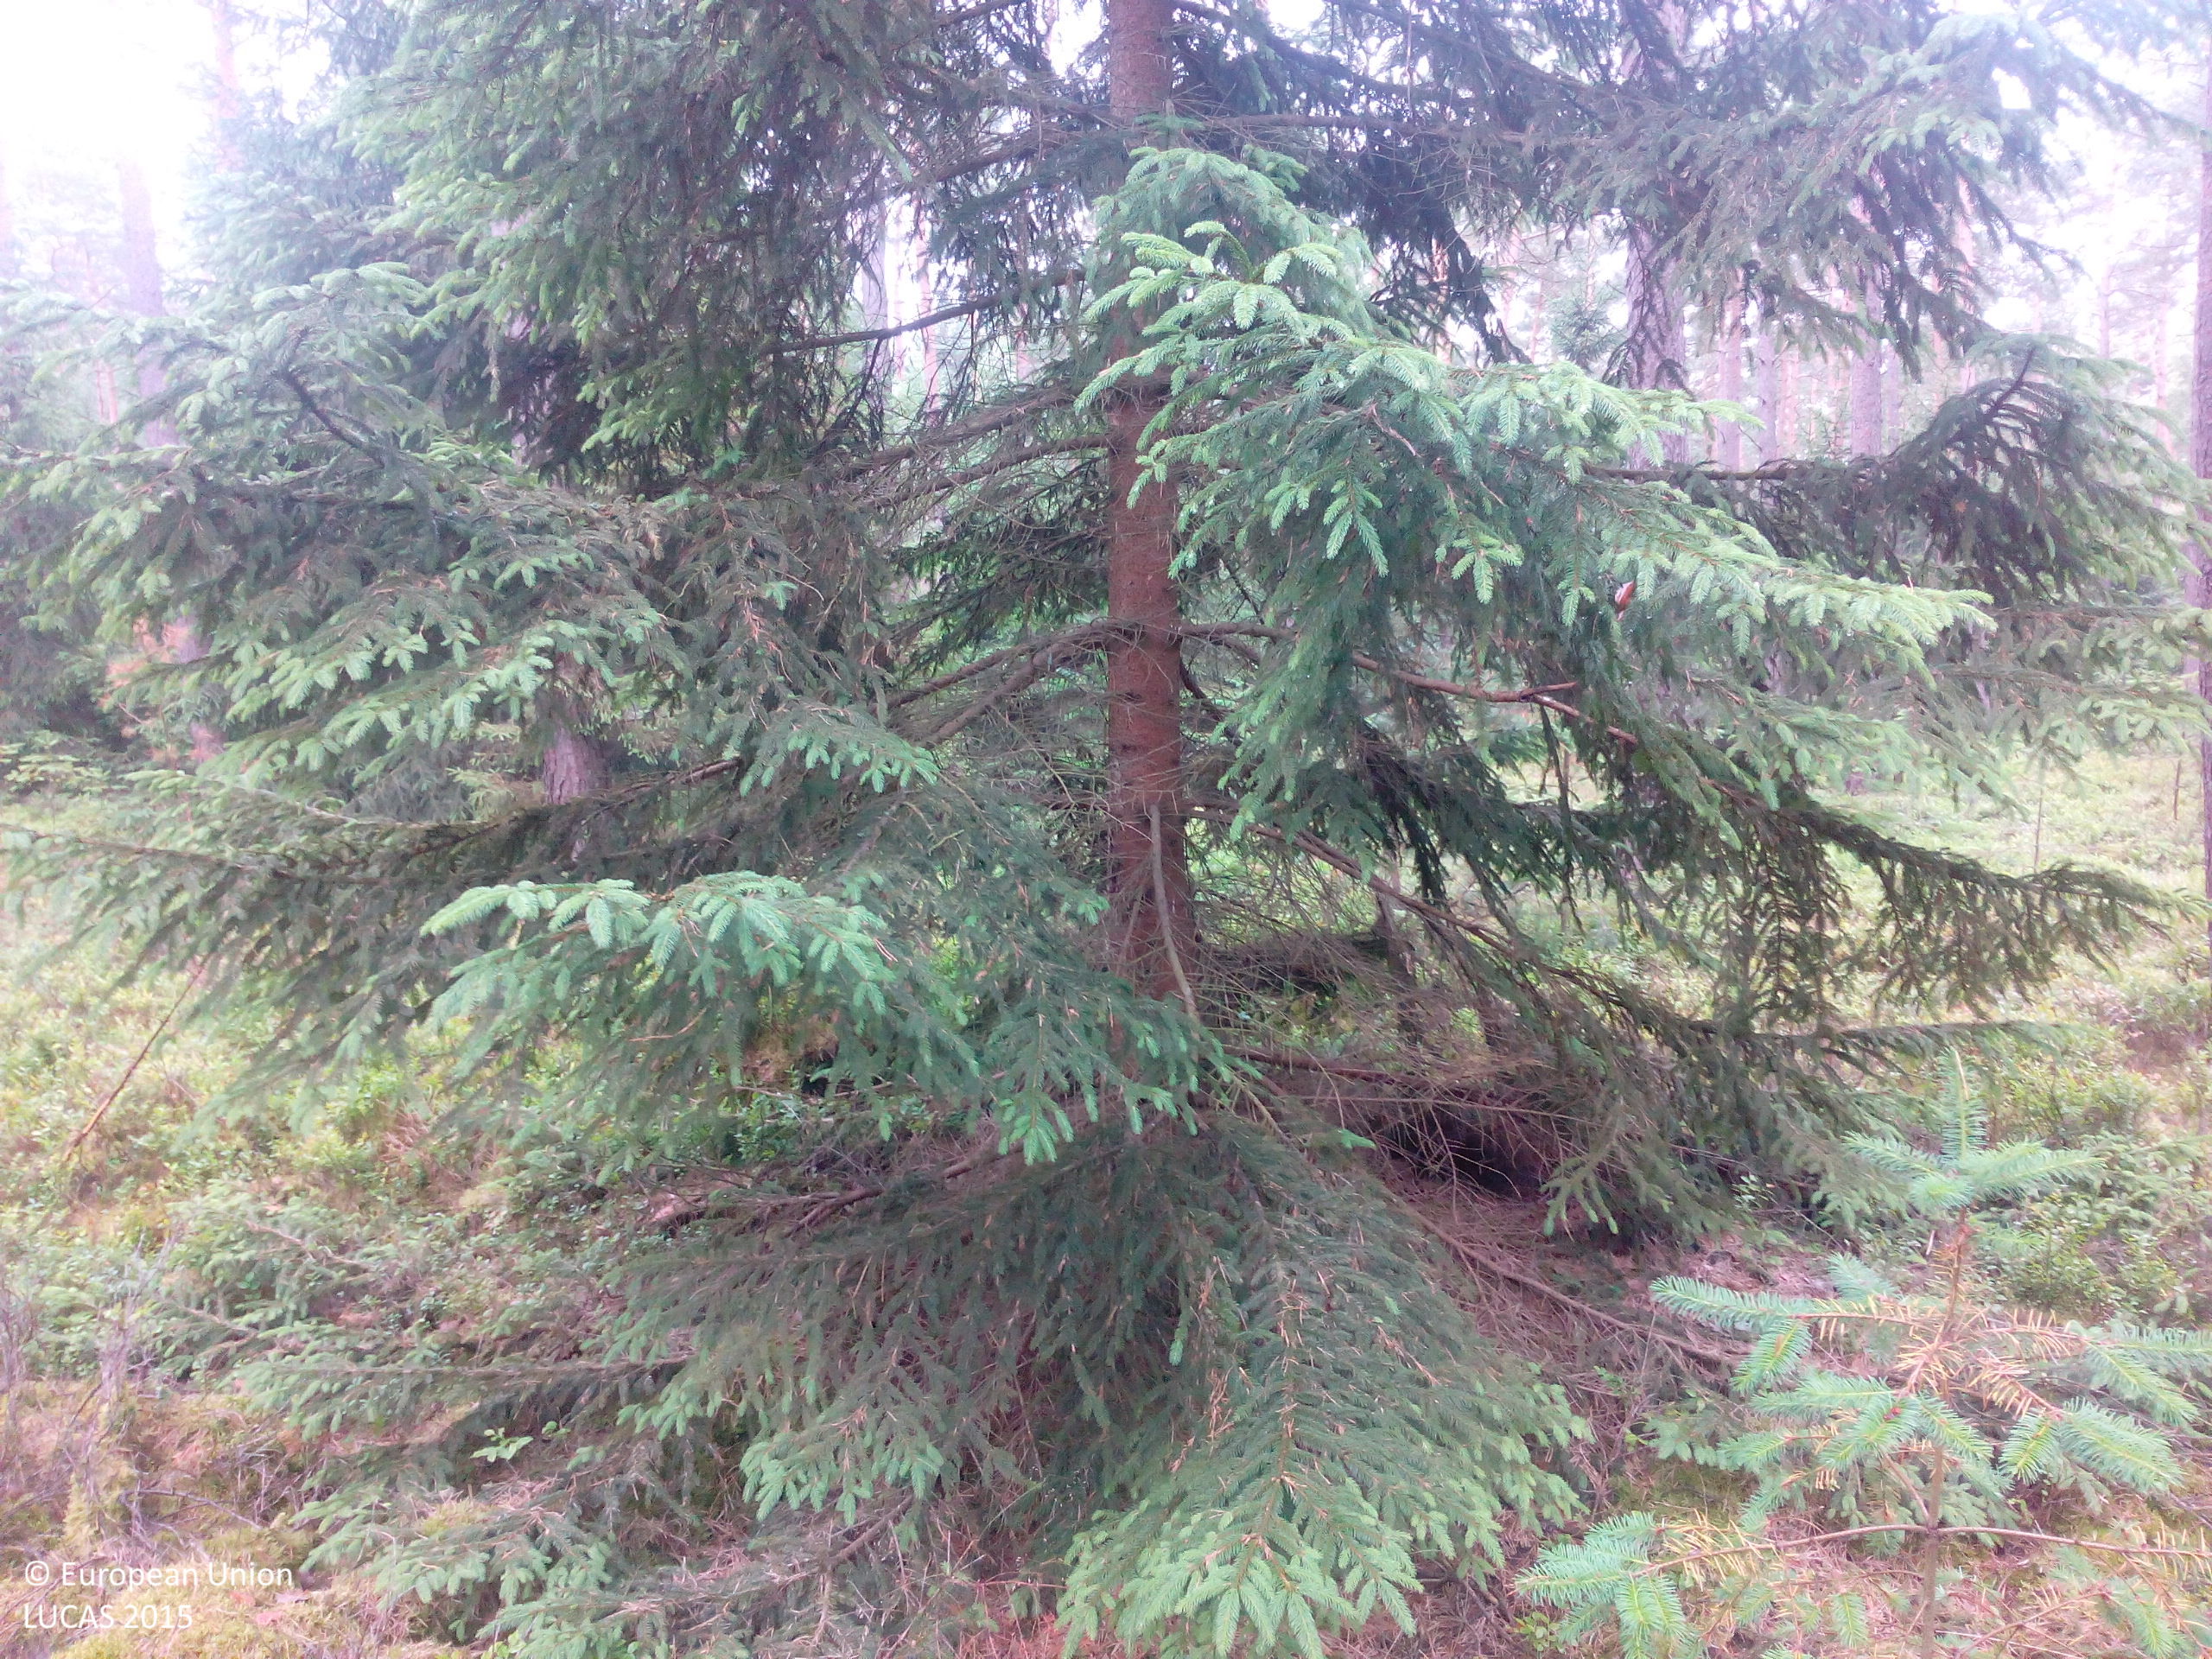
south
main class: Woodland
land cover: Pine dominated coniferous woodland
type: hemiboreal forest and nemoral coniferous forest and mixed broadleaved-coniferous forest
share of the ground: > 75 %
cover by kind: coniferous forest trees 90 %, shrubs 10 %
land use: Forestry
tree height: > 5 m
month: July
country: DE
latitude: 52.8442
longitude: 10.3710
